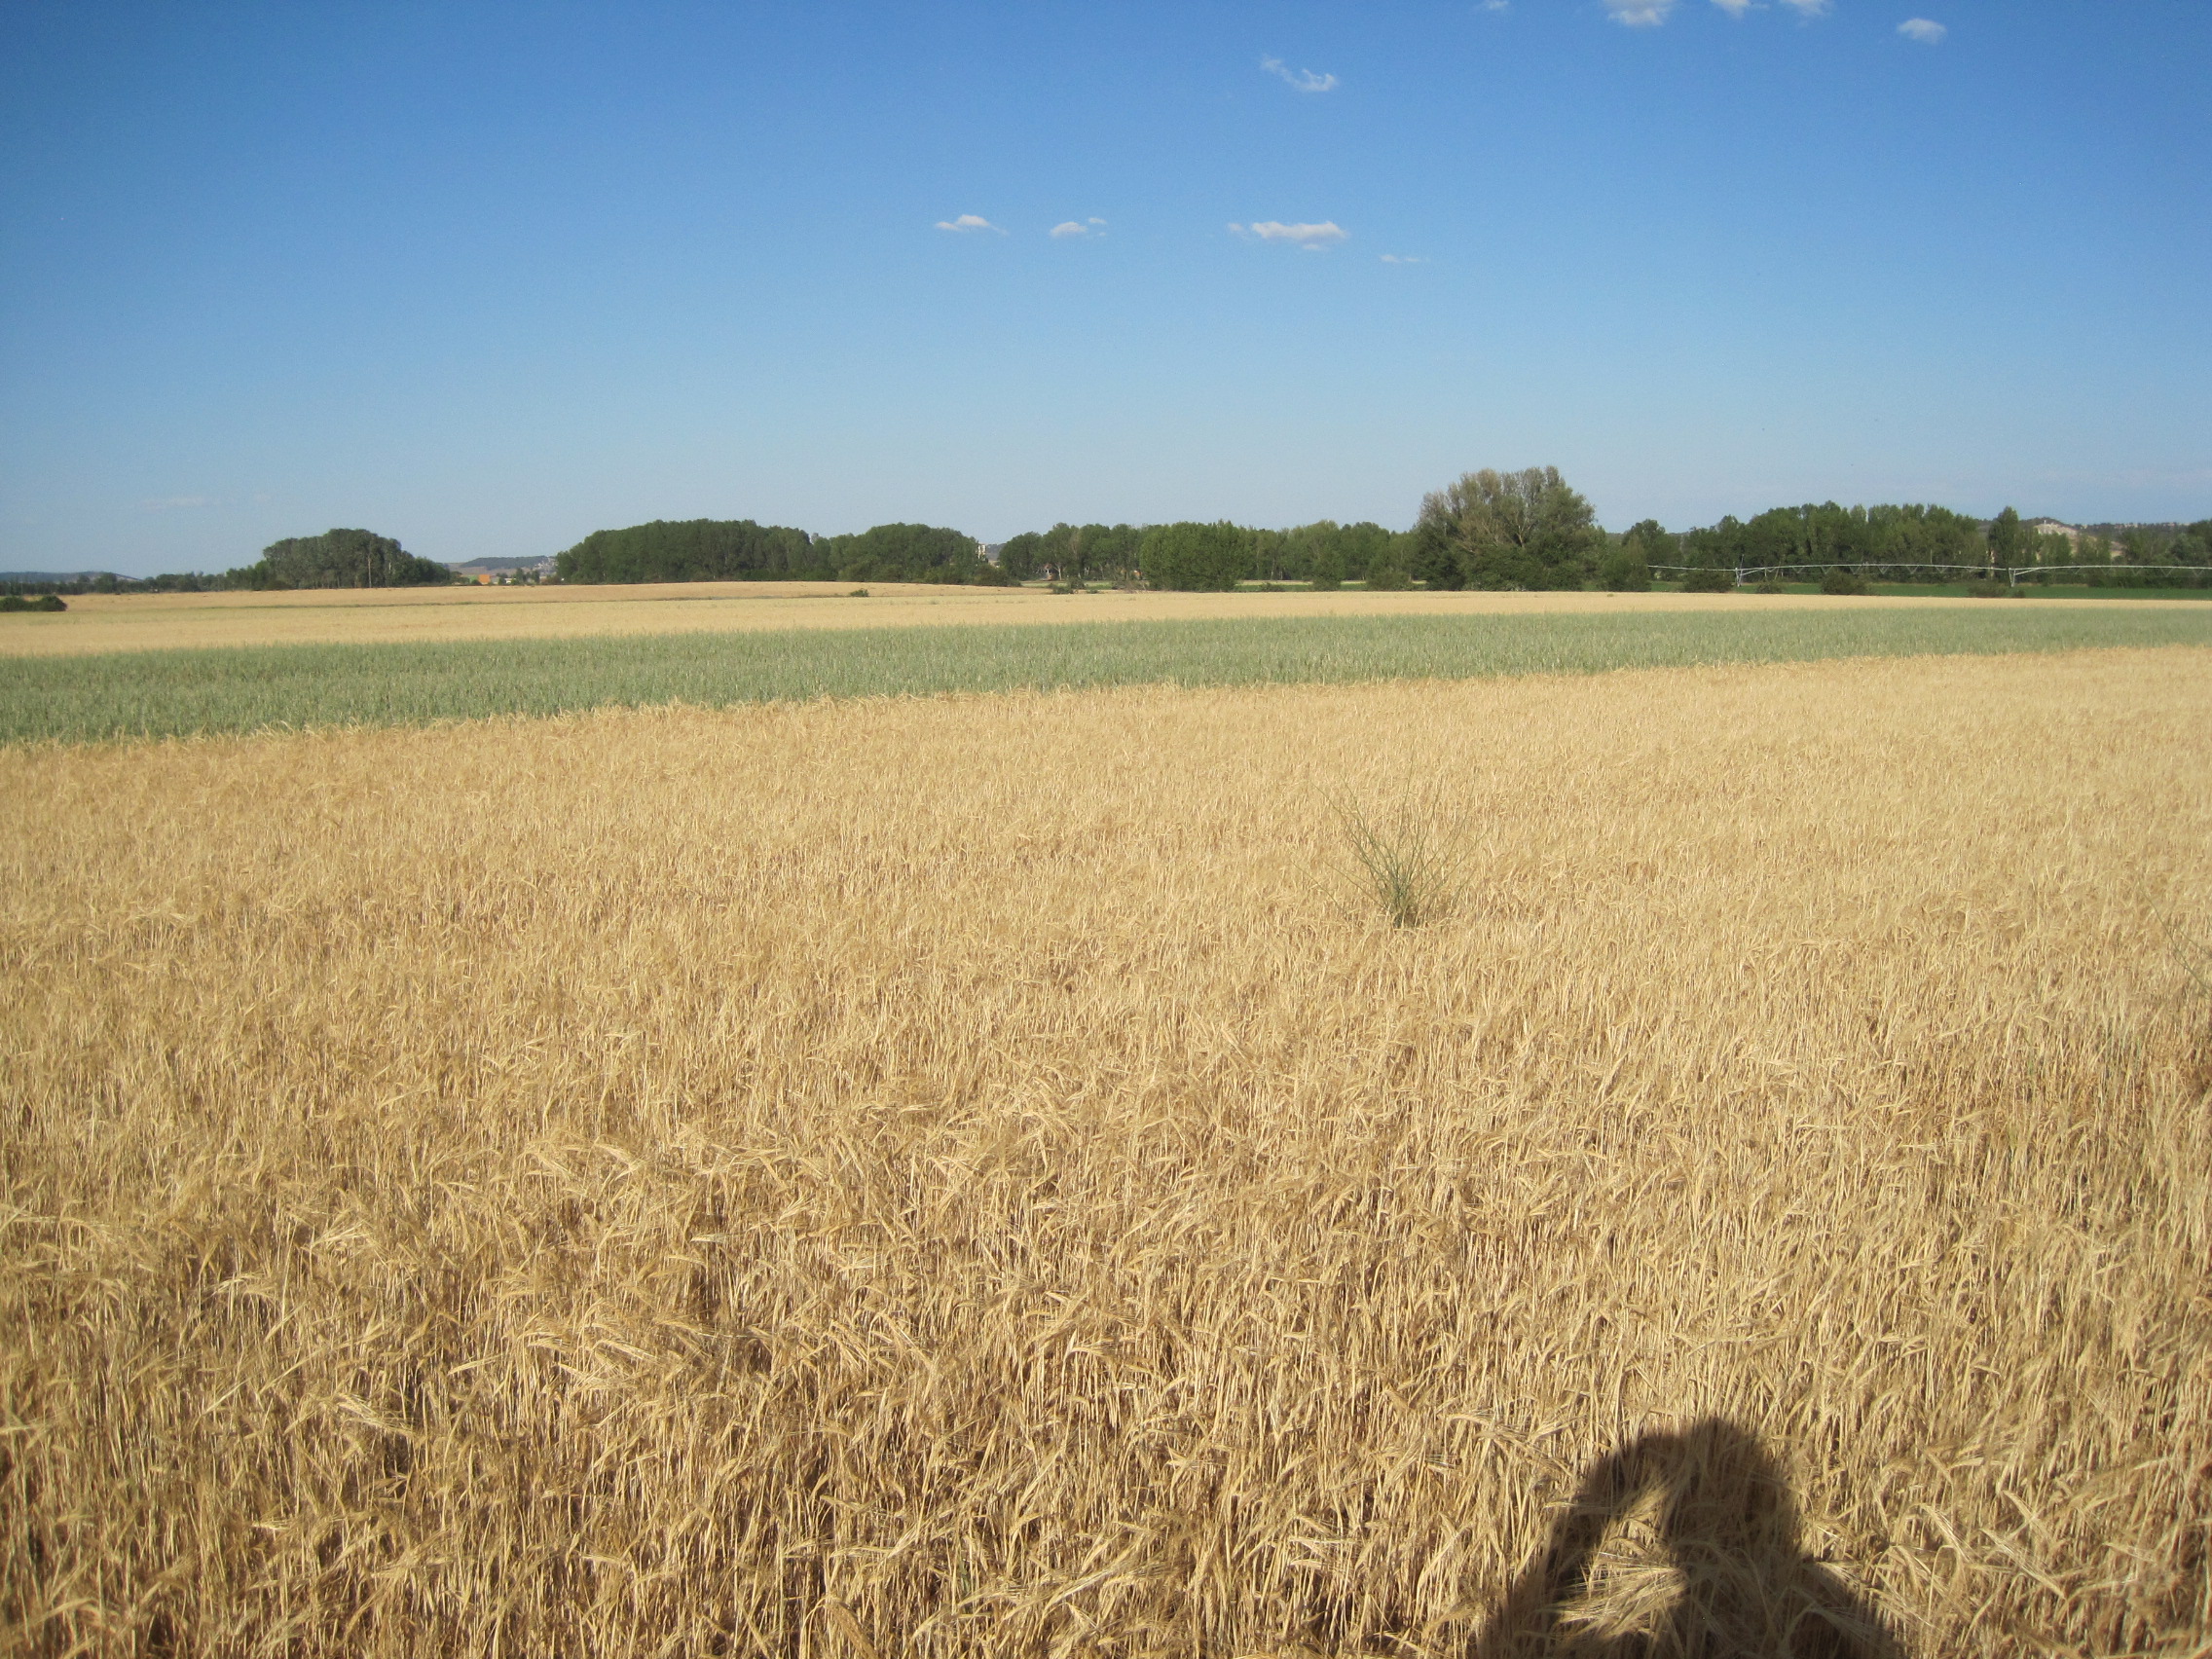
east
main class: Cropland
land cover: Barley
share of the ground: > 75 %
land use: Agriculture (excluding fallow land and kitchen gardens)
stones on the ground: 10 - 25 %
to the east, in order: Barley; Oats; Barley; Grass margins; Common wheat
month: June
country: ES
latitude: 41.8203
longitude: -5.1395
